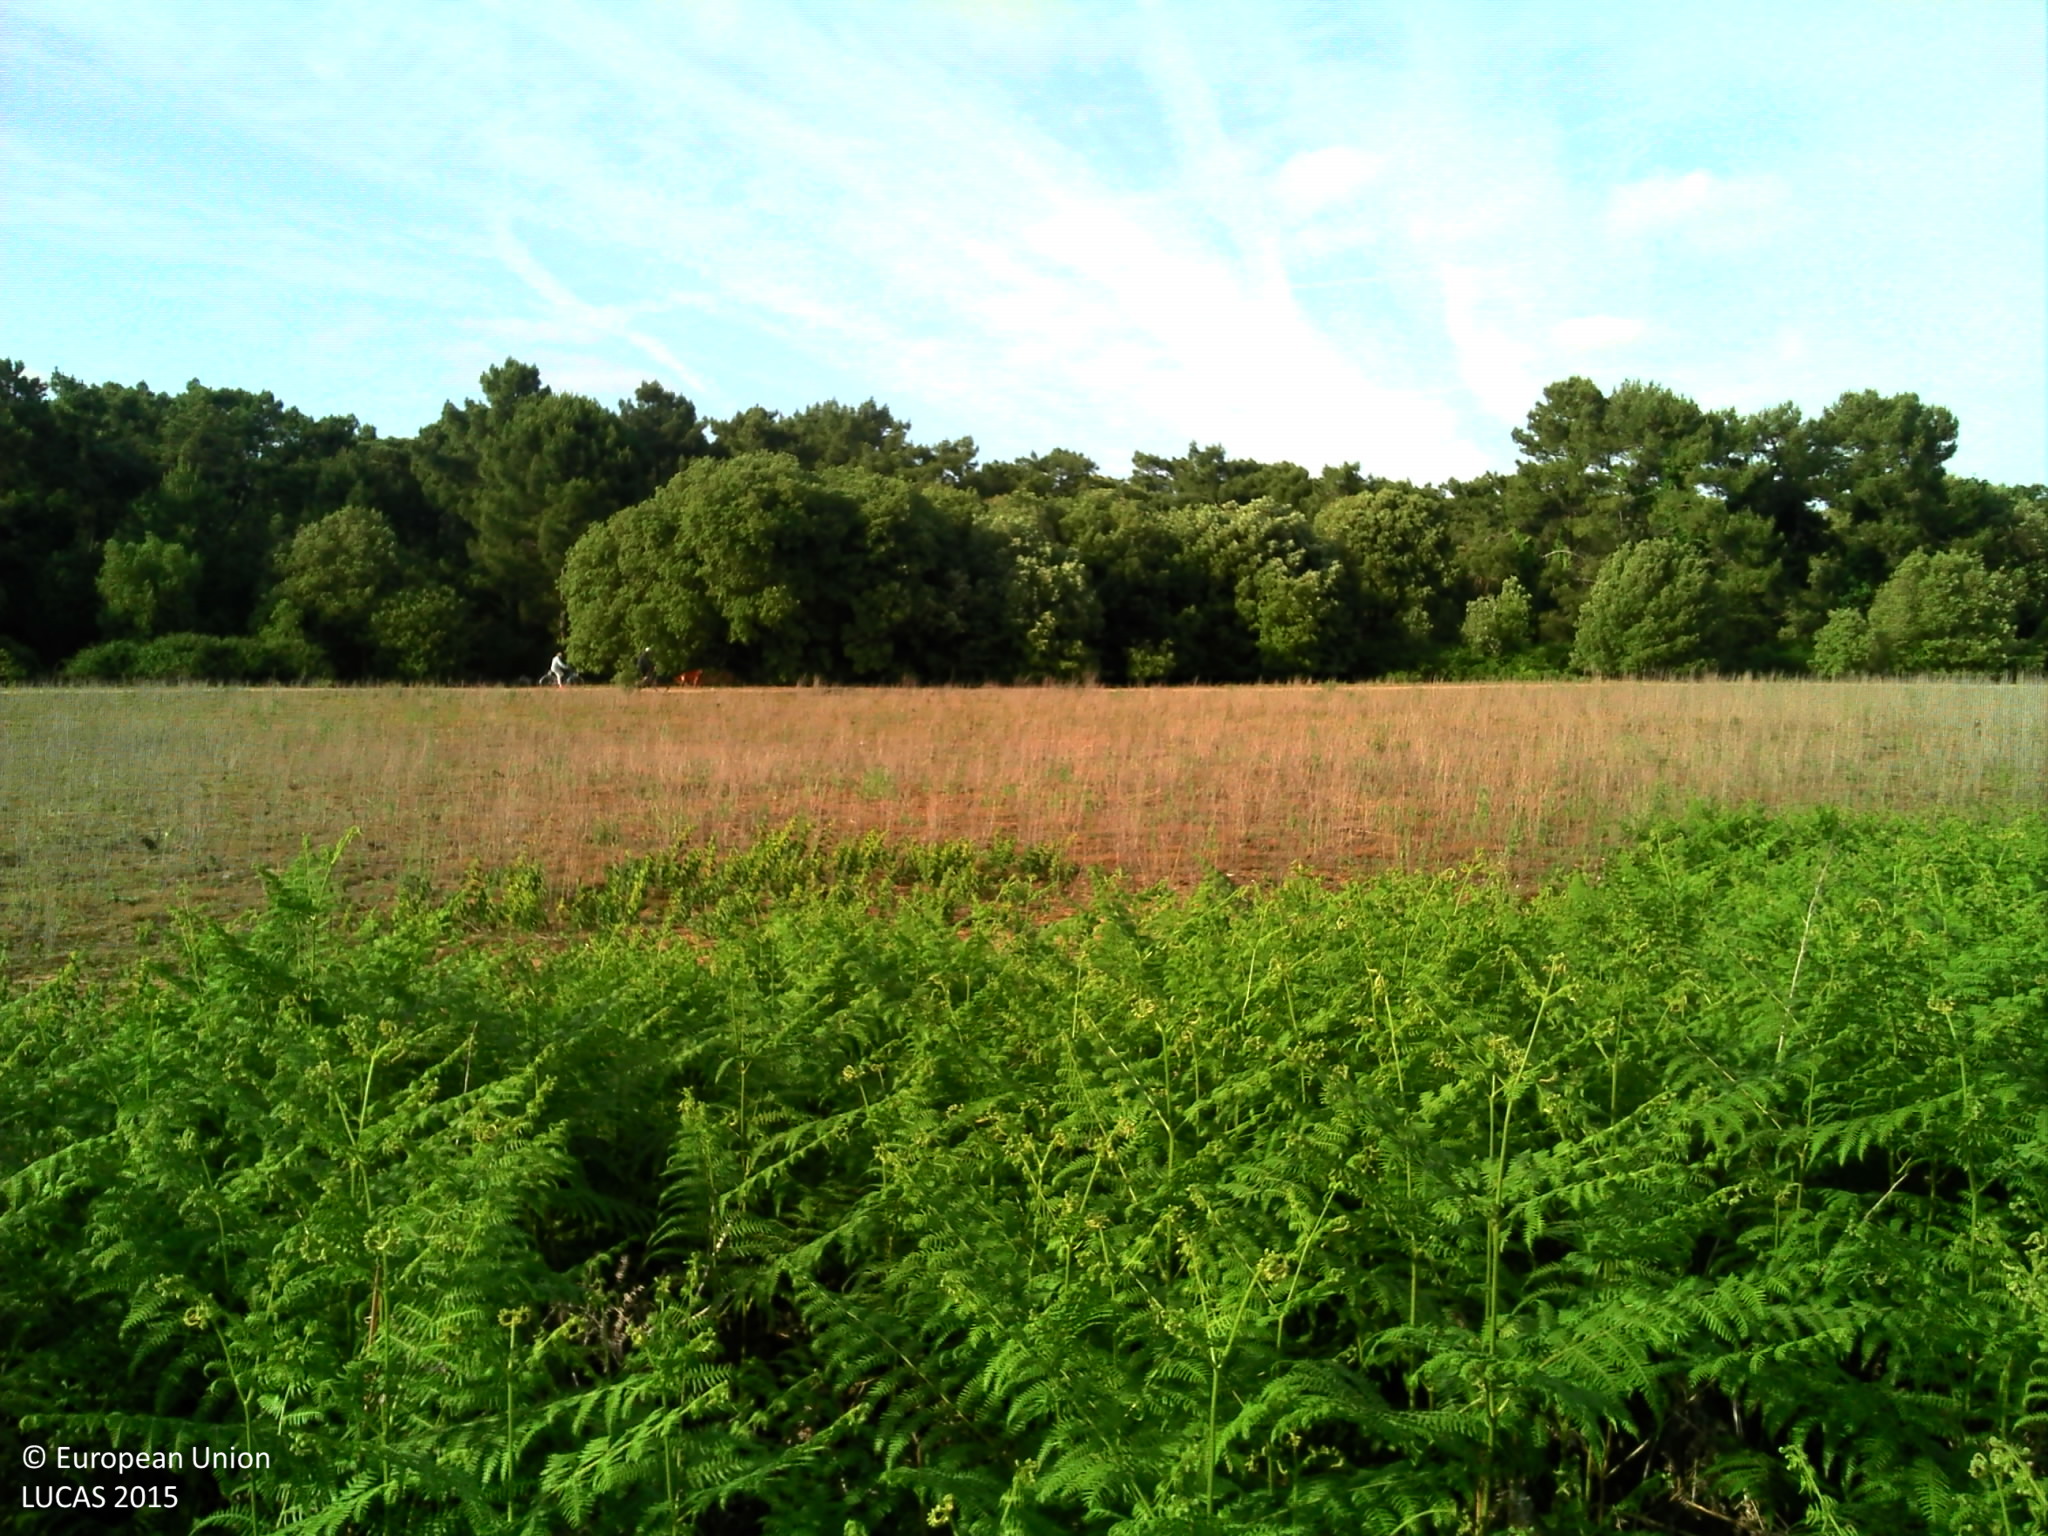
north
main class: Grassland
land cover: Spontaneously vegetated surfaces
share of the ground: > 75 %
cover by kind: herbaceous plants 95 %, shrubs 5 %
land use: Semi-natural and natural areas not in use
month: May
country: FR
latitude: 46.1669
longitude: -1.3145
